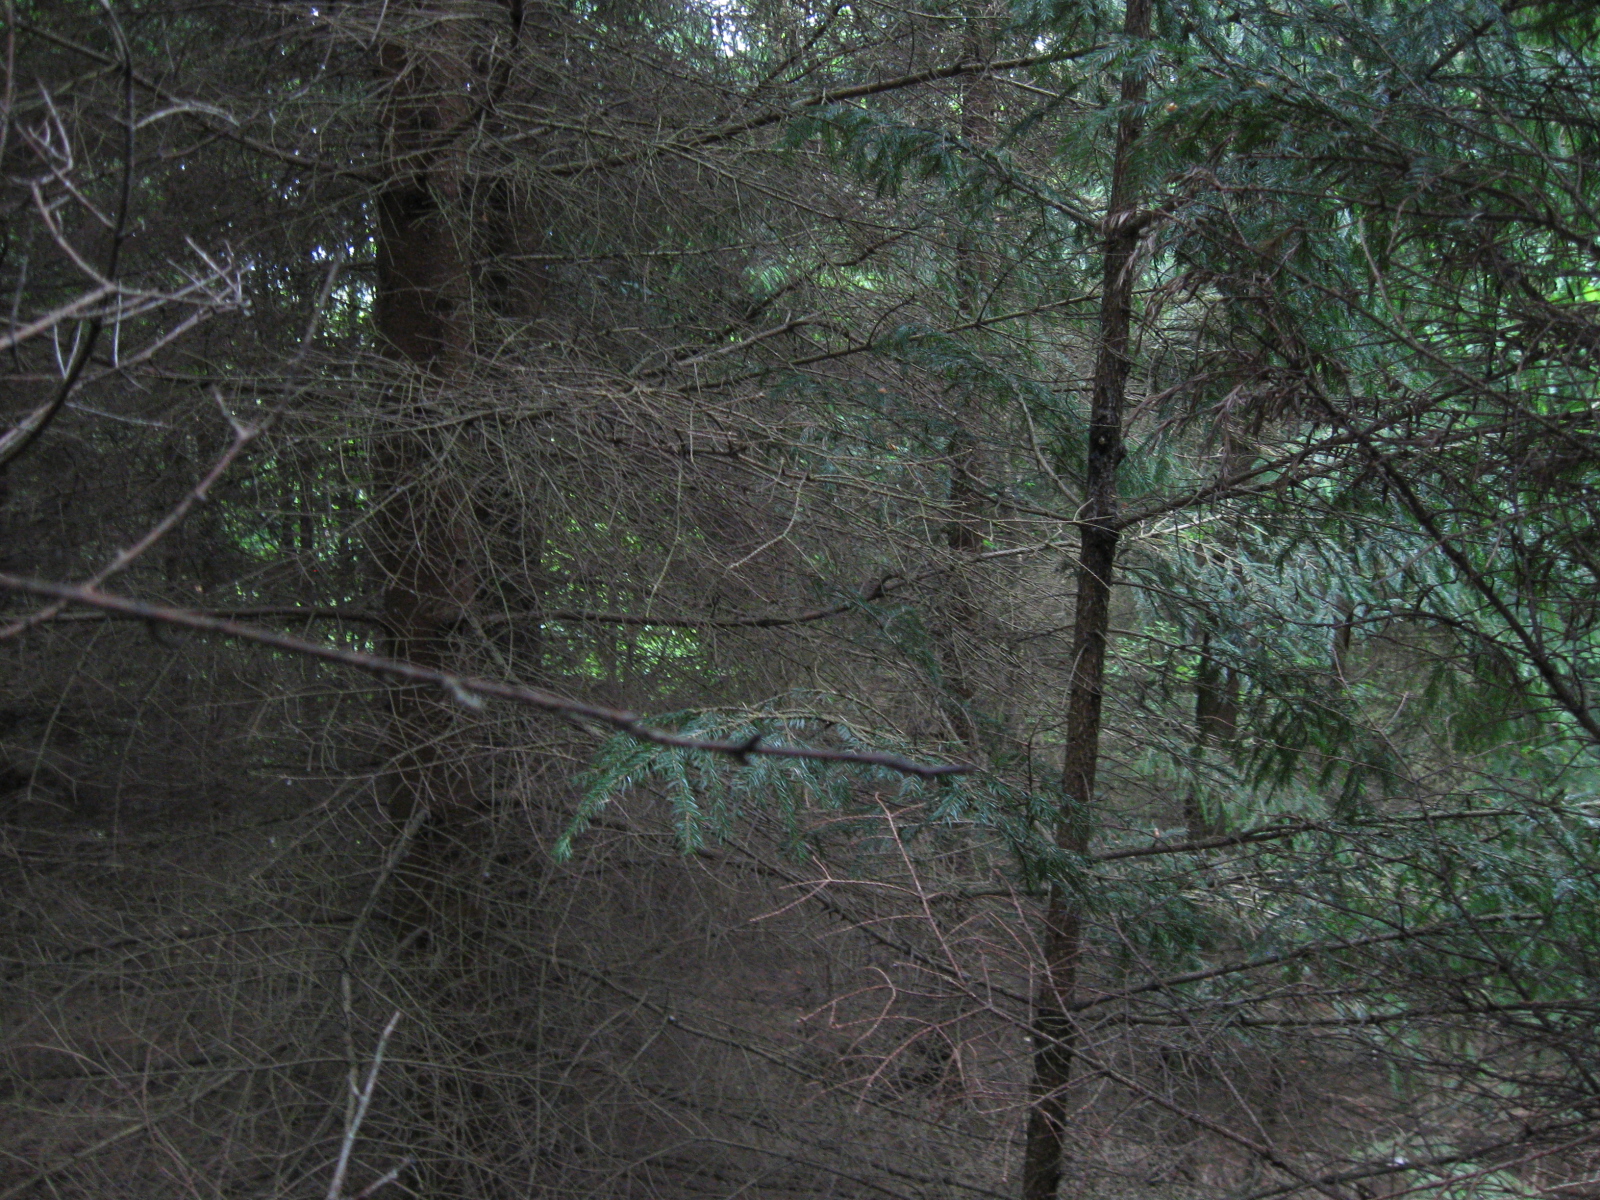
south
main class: Woodland
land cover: Spruce dominated coniferous woodland
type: hemiboreal forest and nemoral coniferous forest and mixed broadleaved-coniferous forest
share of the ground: > 75 %
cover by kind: coniferous forest trees 85 %, broadleaved forest trees 15 %
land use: Forestry
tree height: > 5 m
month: June
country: LT
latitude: 54.6025
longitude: 24.3885
